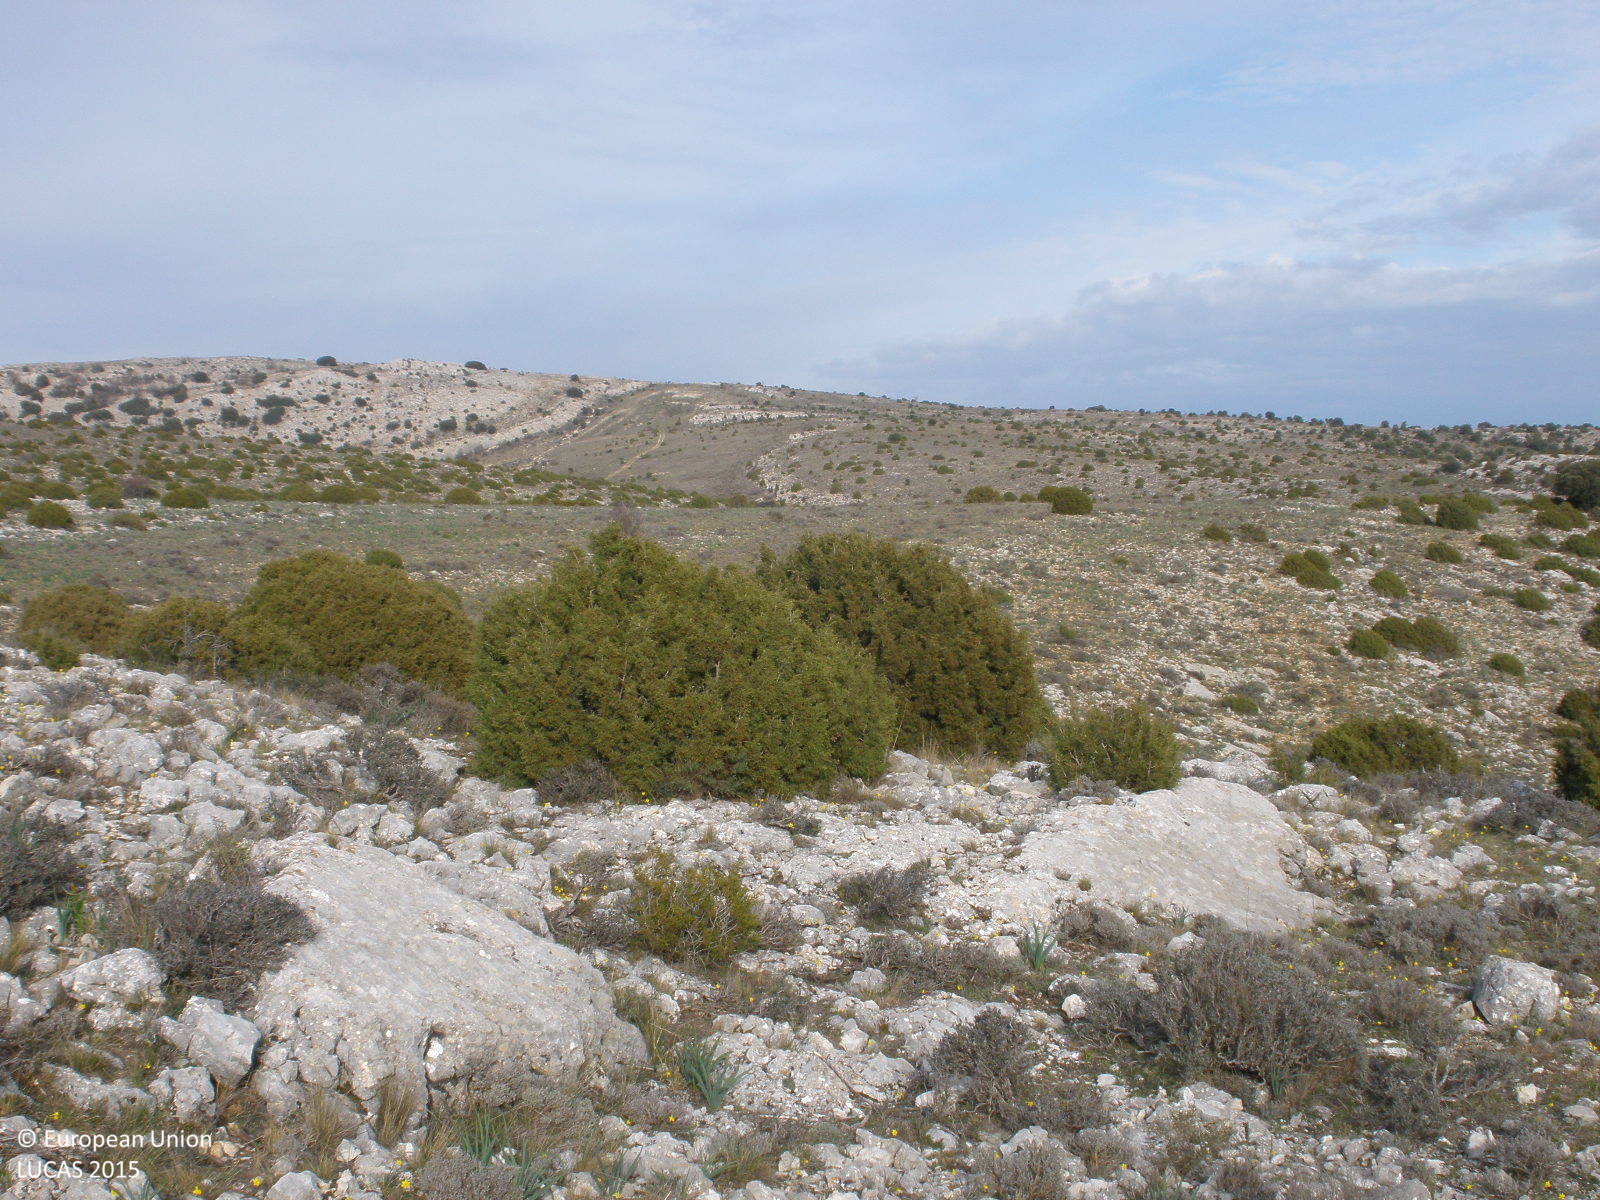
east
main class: Woodland
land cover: Other coniferous woodland
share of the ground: 10 - 25 %
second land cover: Grassland without tree/shrub cover
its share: 10 - 25 %
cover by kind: shrubs 30 %, herbaceous plants 30 %, coniferous forest trees 20 %, consolidated bare surface 10 %, unconsolidated bare surface 10 %
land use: Forestry
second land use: Agriculture (excluding fallow land and kitchen gardens)
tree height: < 5 m
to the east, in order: Other coniferous woodland; Grassland without tree/shrub cover; Shrubland with sparse tree cover; Other mixed woodland
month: April
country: ES
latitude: 41.0506
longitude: -1.1663
